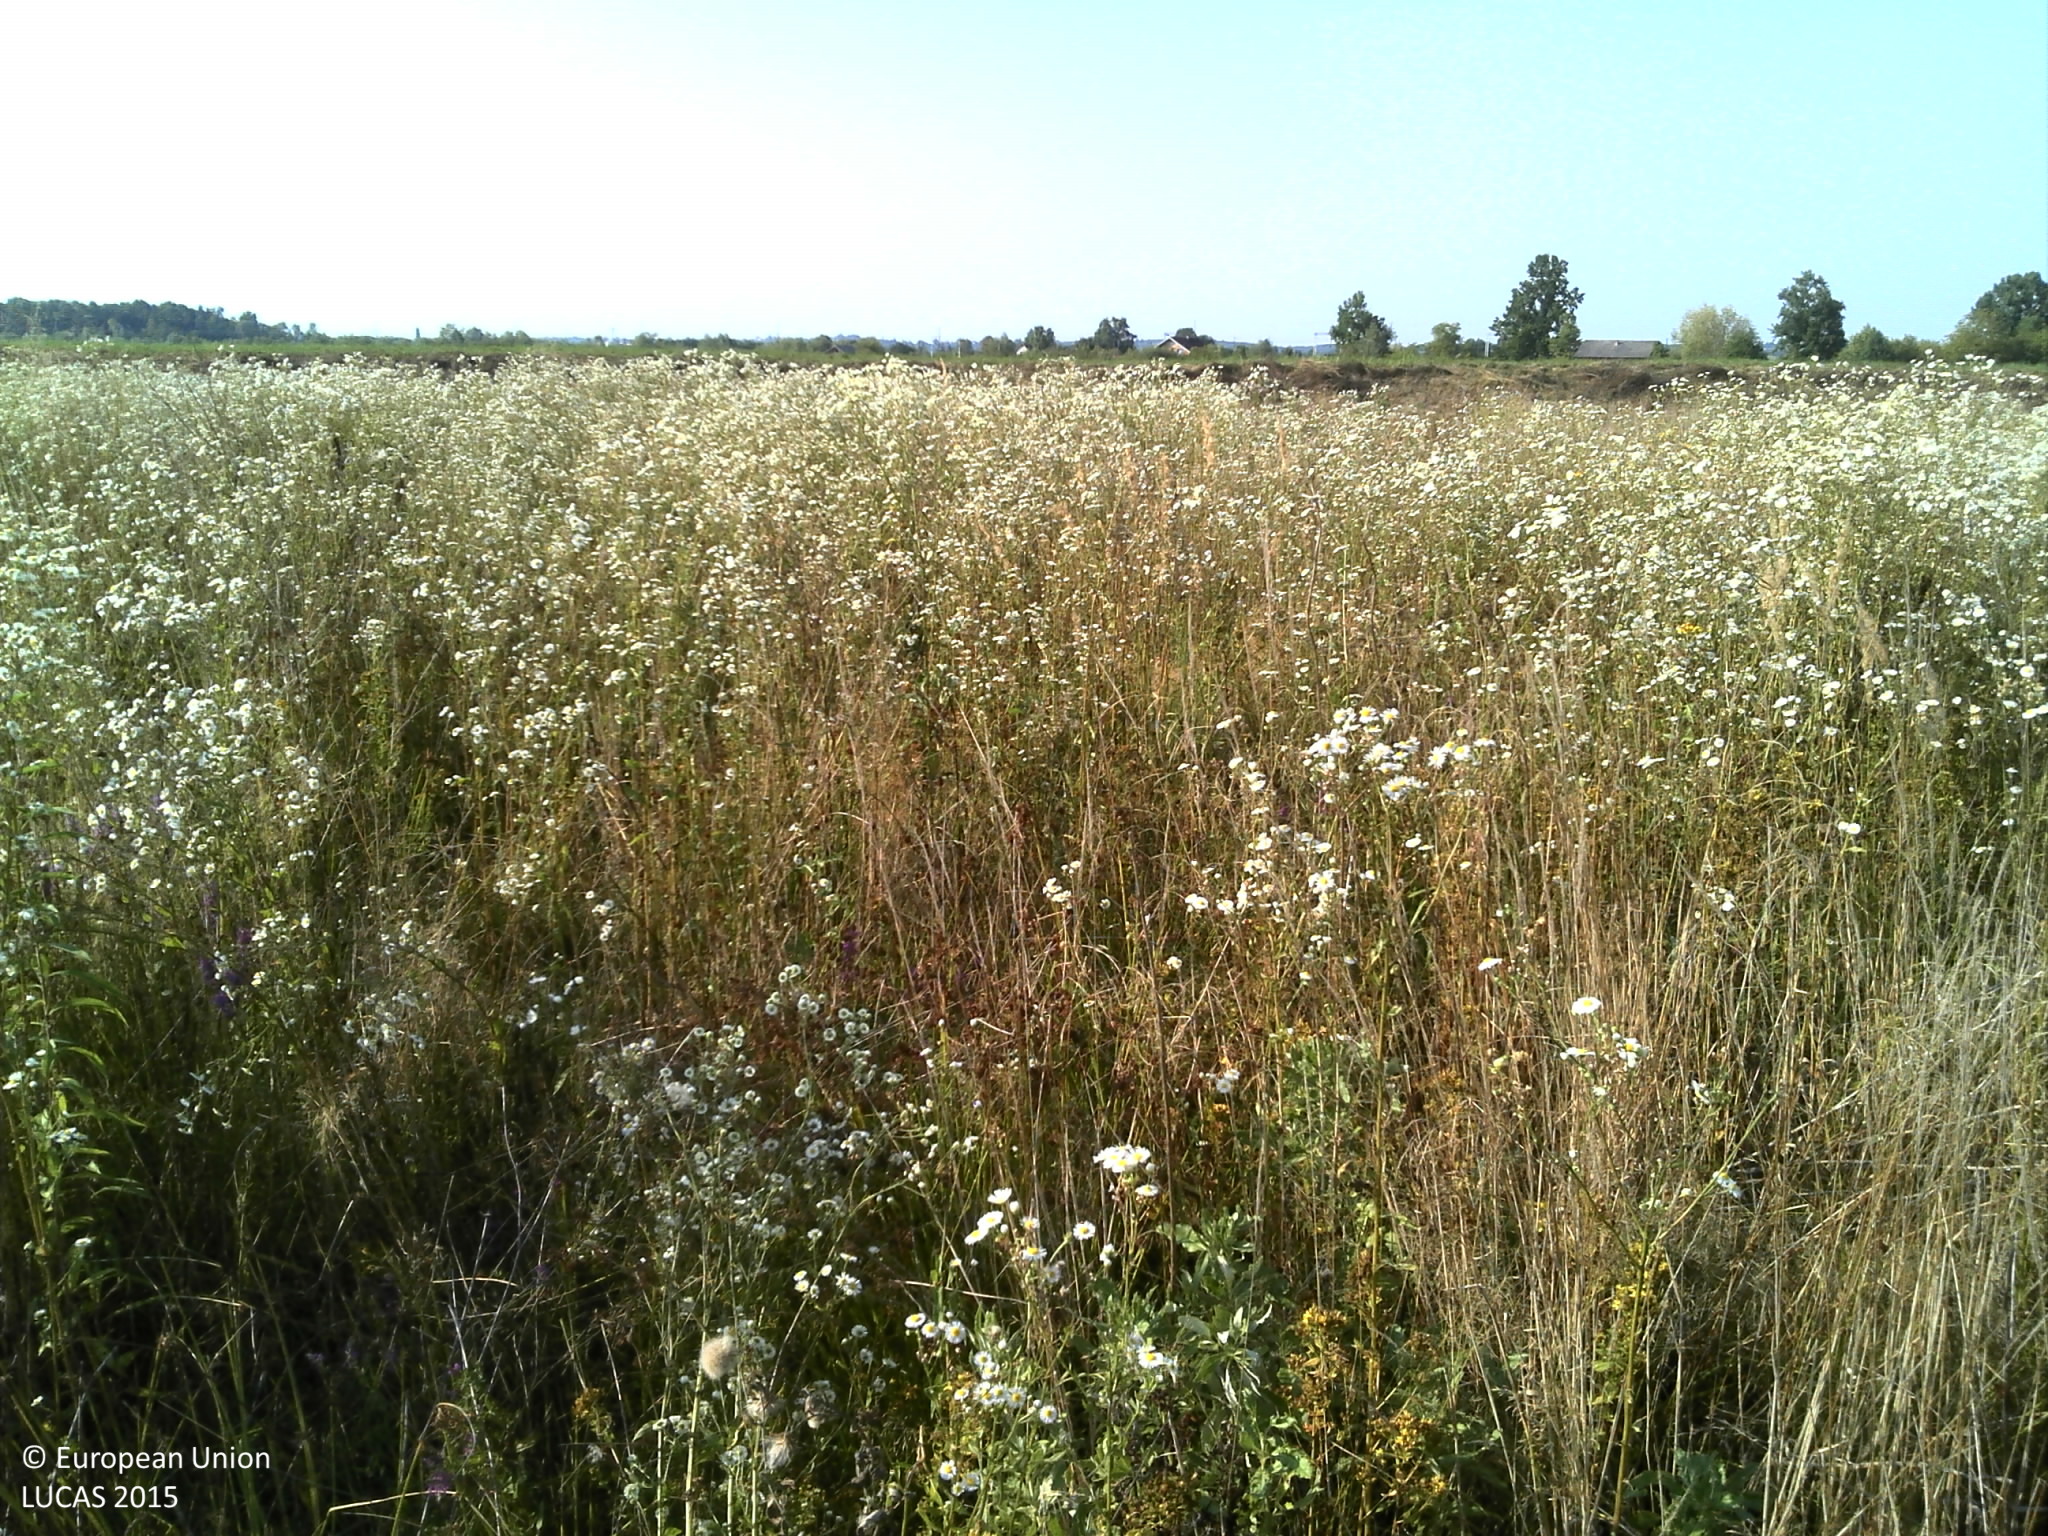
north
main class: Grassland
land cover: Spontaneously vegetated surfaces
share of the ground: > 75 %
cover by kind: herbaceous plants 100 %
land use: Fallow land
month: August
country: HR
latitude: 45.6862
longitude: 16.4572
